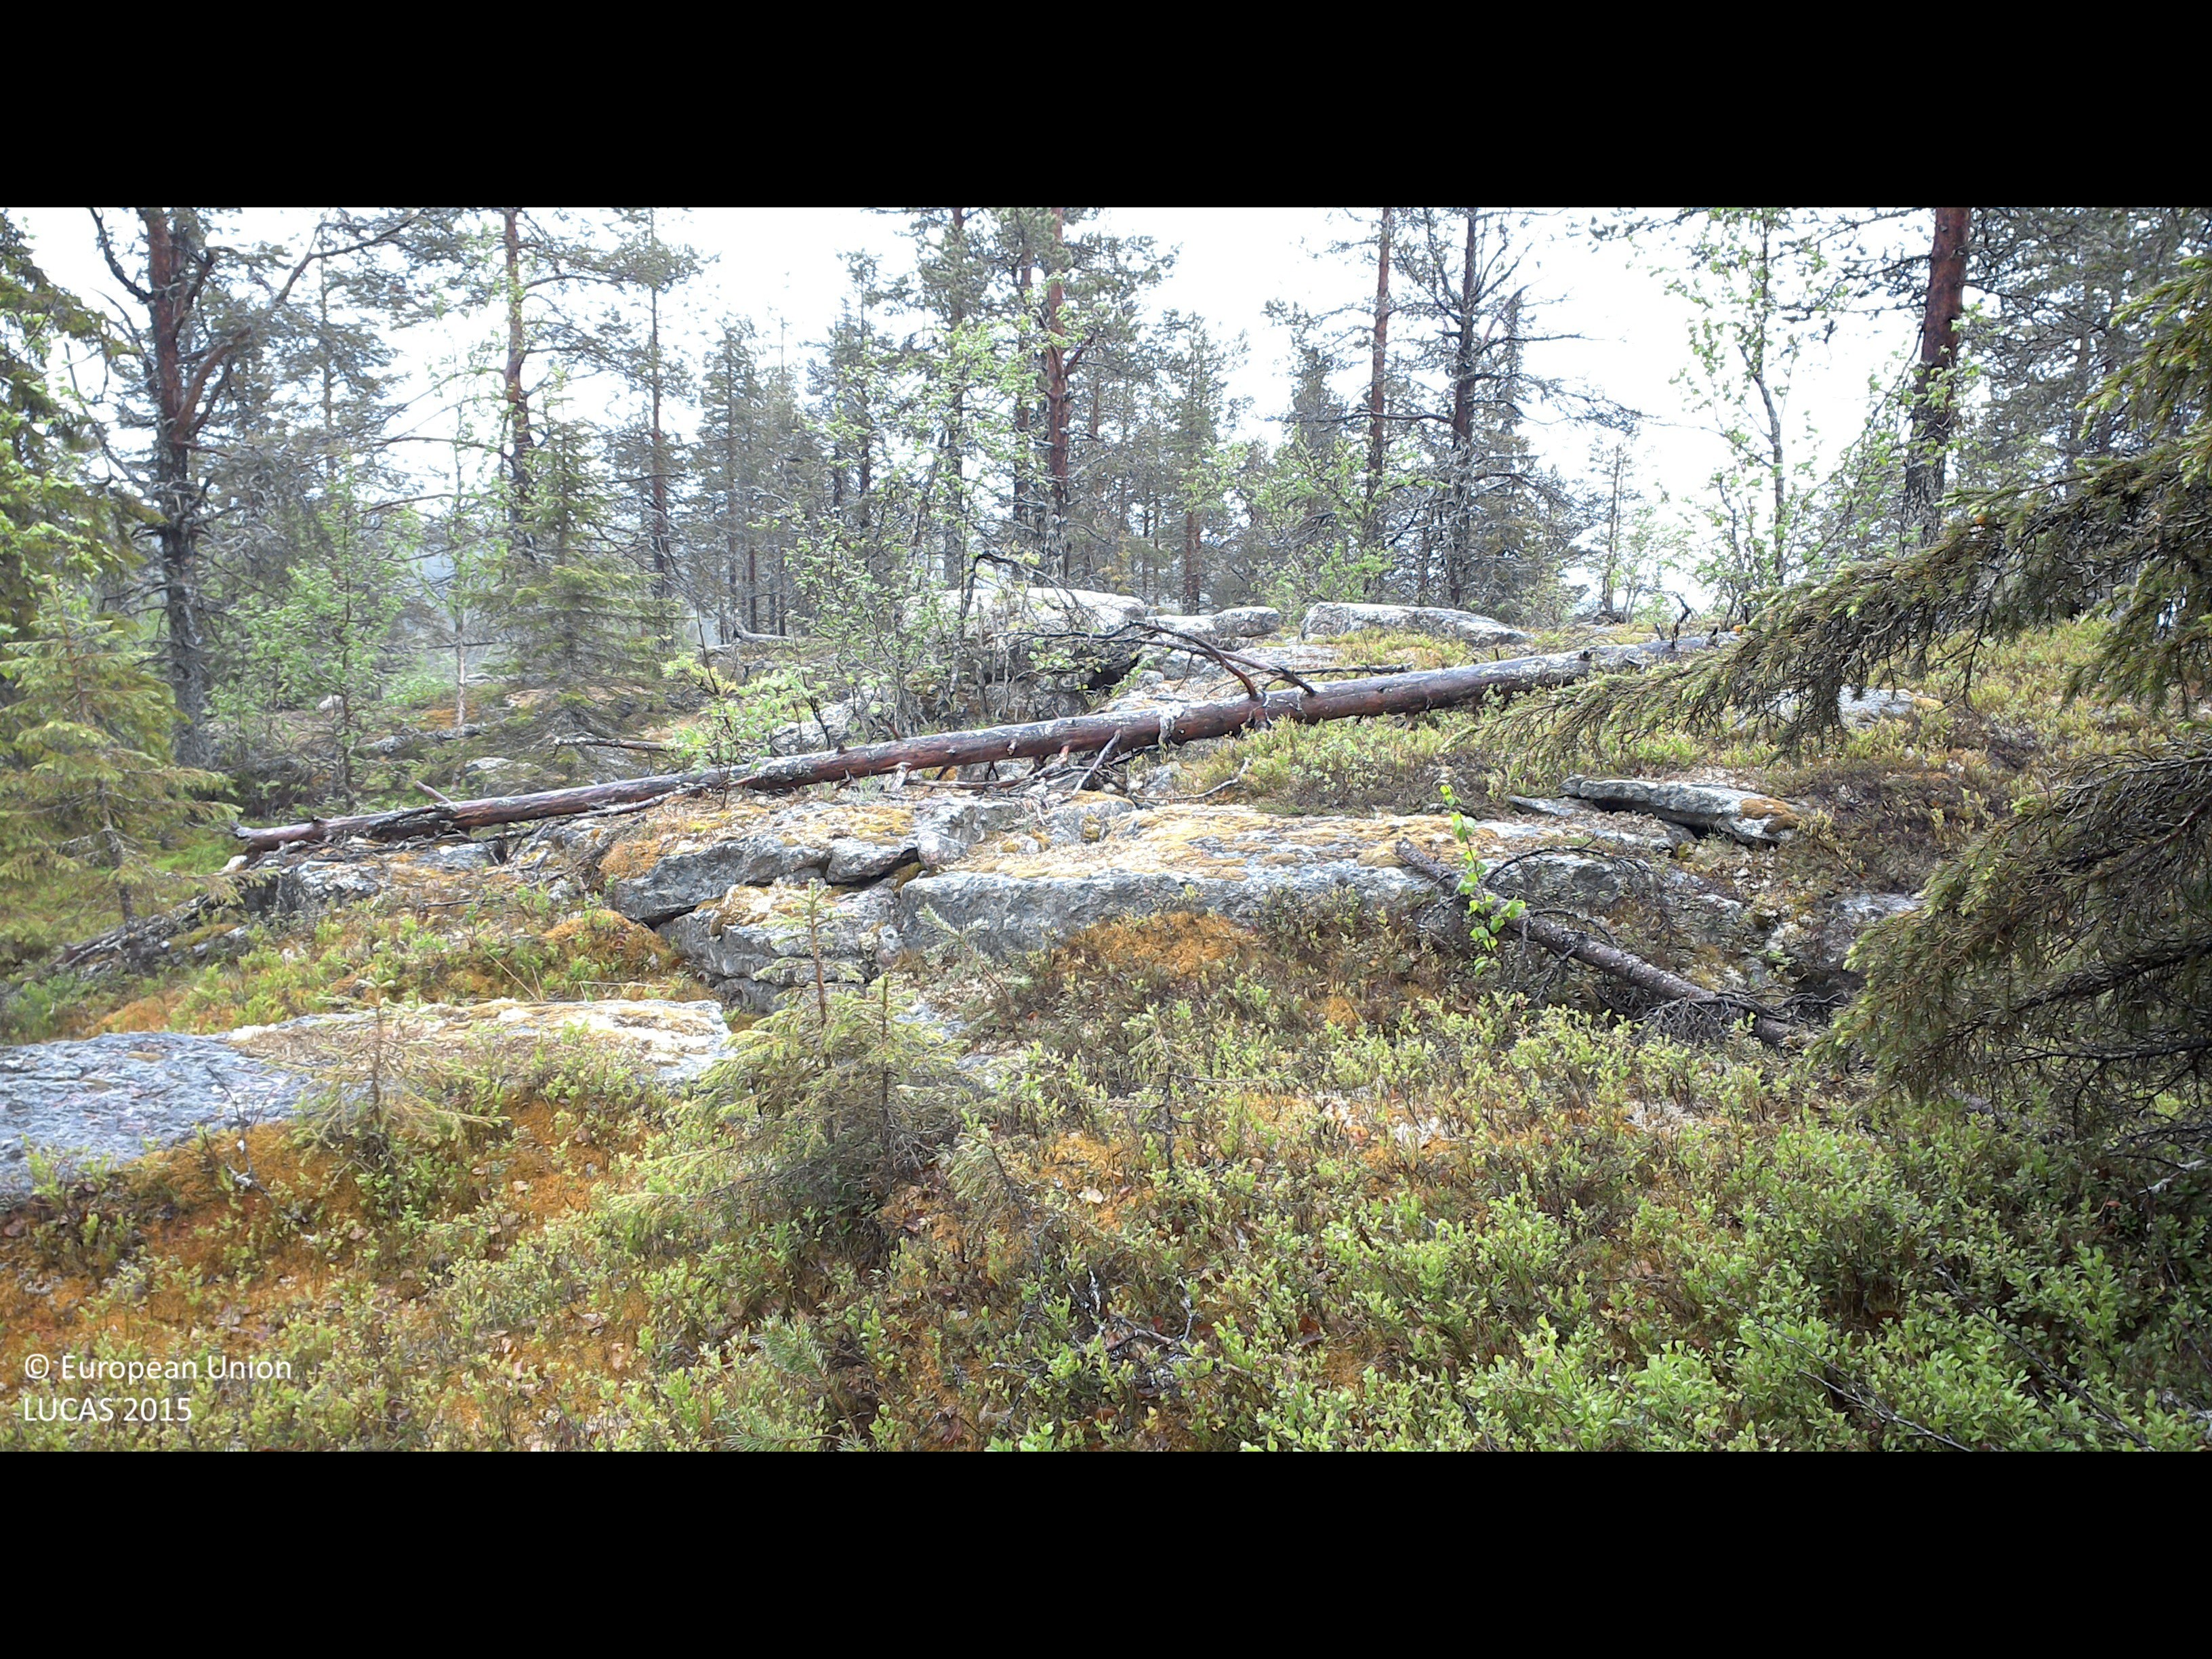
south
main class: Woodland
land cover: Spruce dominated mixed woodland
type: boreal forest
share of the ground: 25 - 50 %
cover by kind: shrubs 40 %, lichens and mosses 30 %, coniferous forest trees 15 %, broadleaved forest trees 10 %, unconsolidated bare surface 5 %
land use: Forestry
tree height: > 5 m
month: June
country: SE
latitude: 67.0358
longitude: 22.0646
